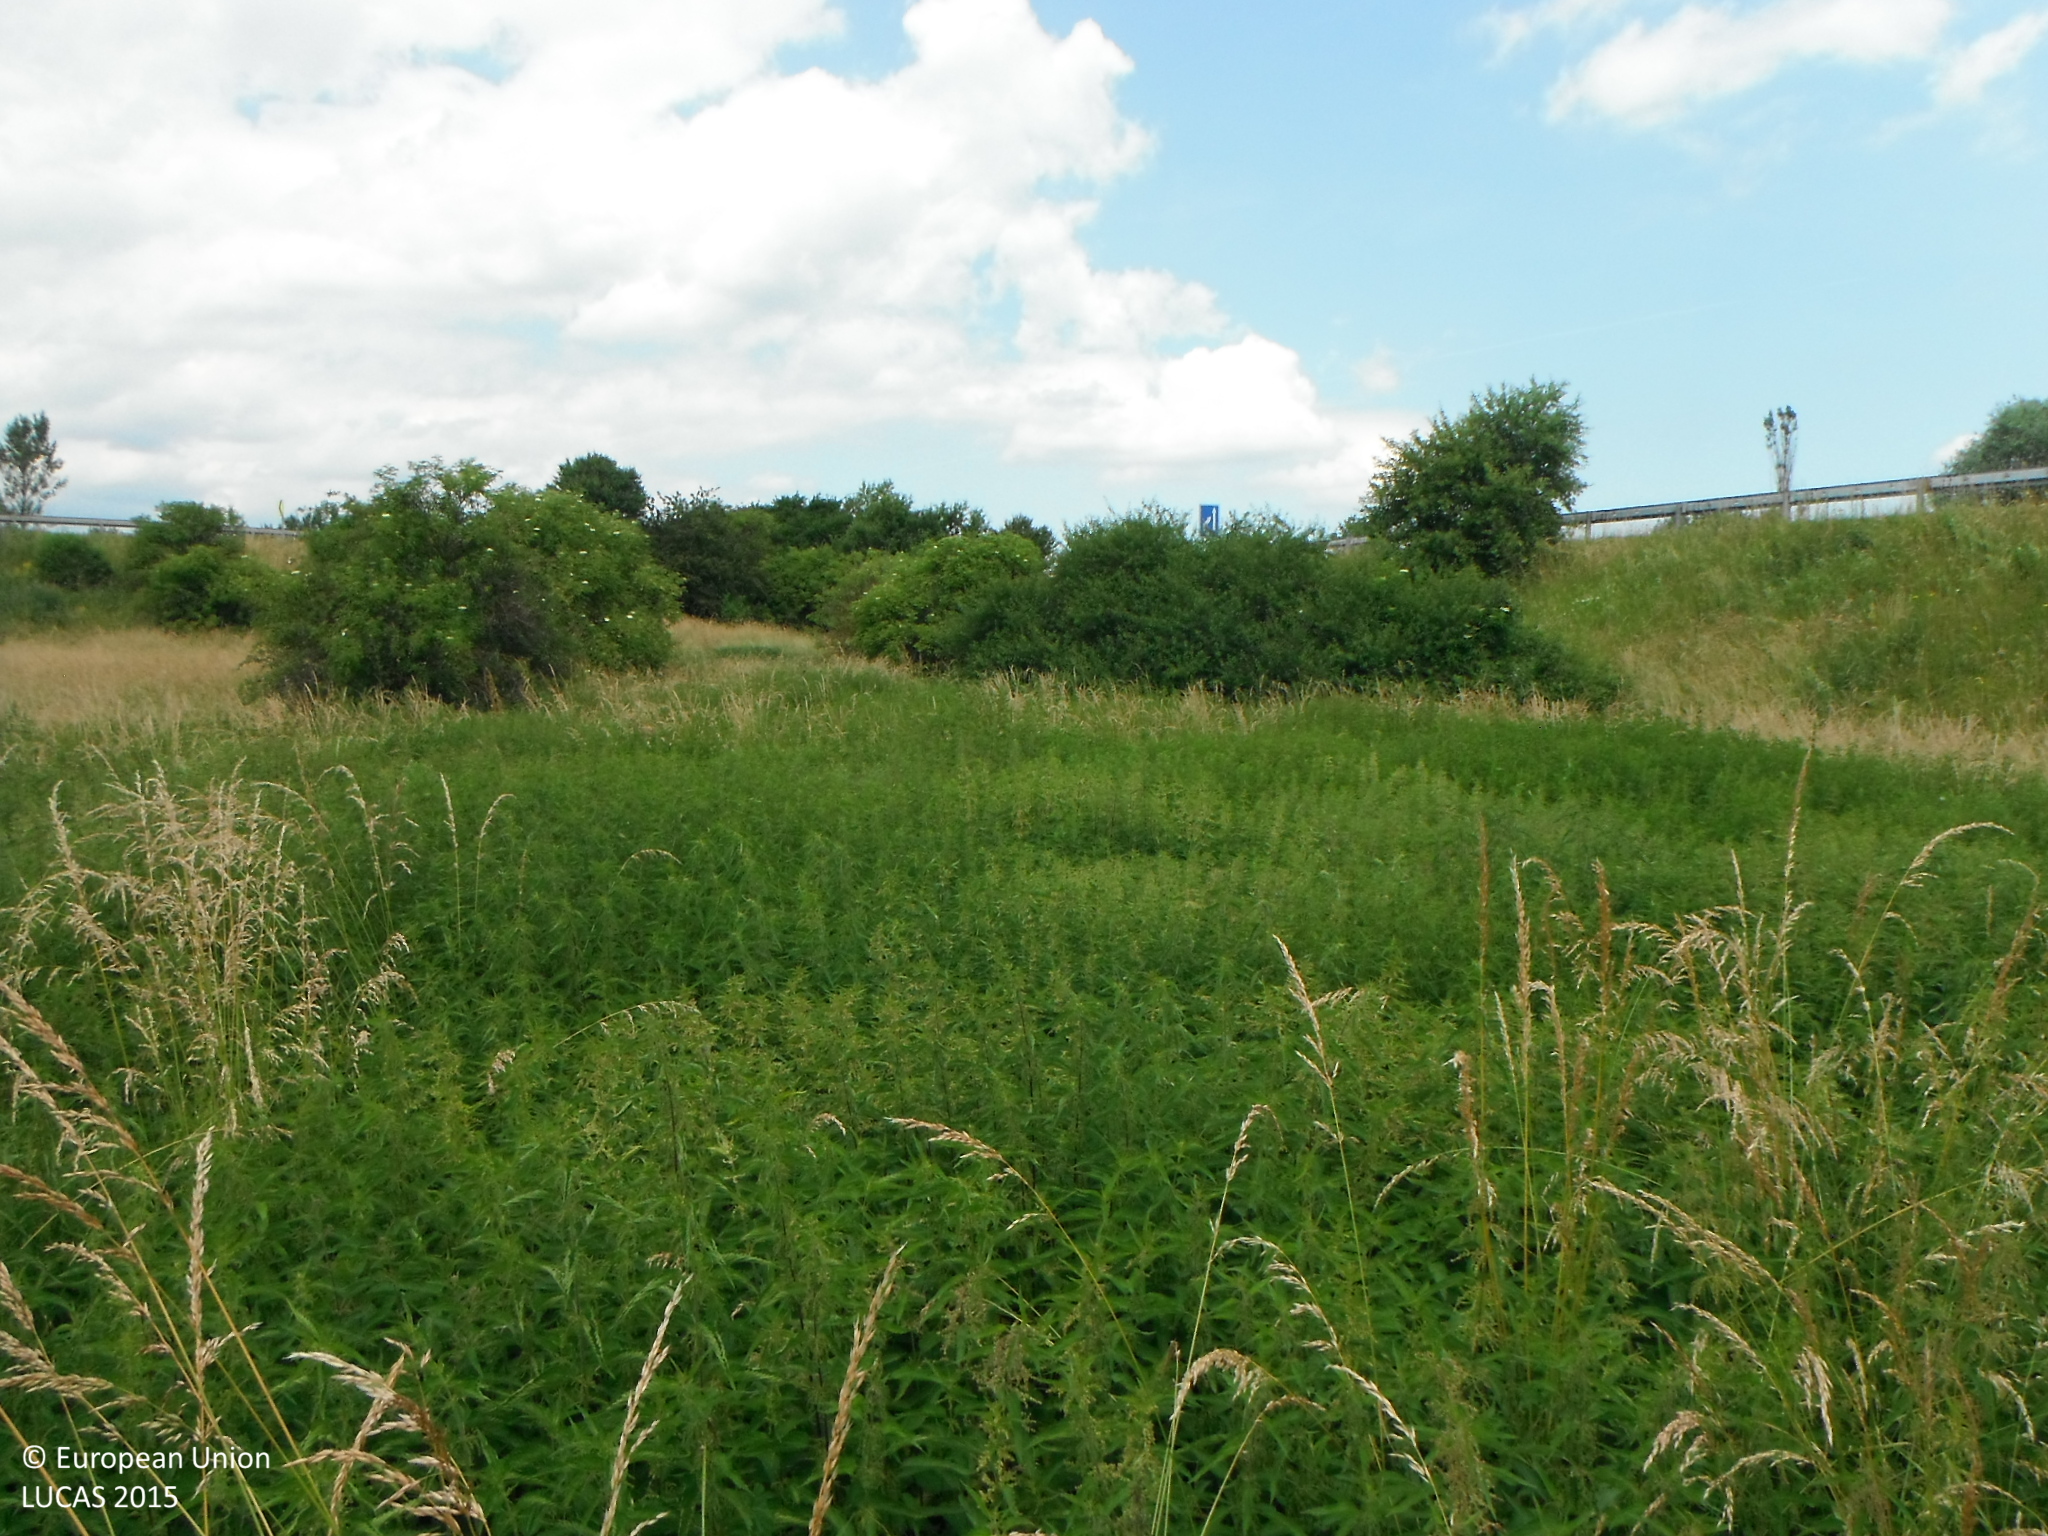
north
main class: Grassland
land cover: Grassland without tree/shrub cover
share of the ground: > 75 %
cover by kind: herbaceous plants 100 %
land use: Protection infrastructures
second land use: Road transport
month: June
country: SK
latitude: 48.6052
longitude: 19.1218
